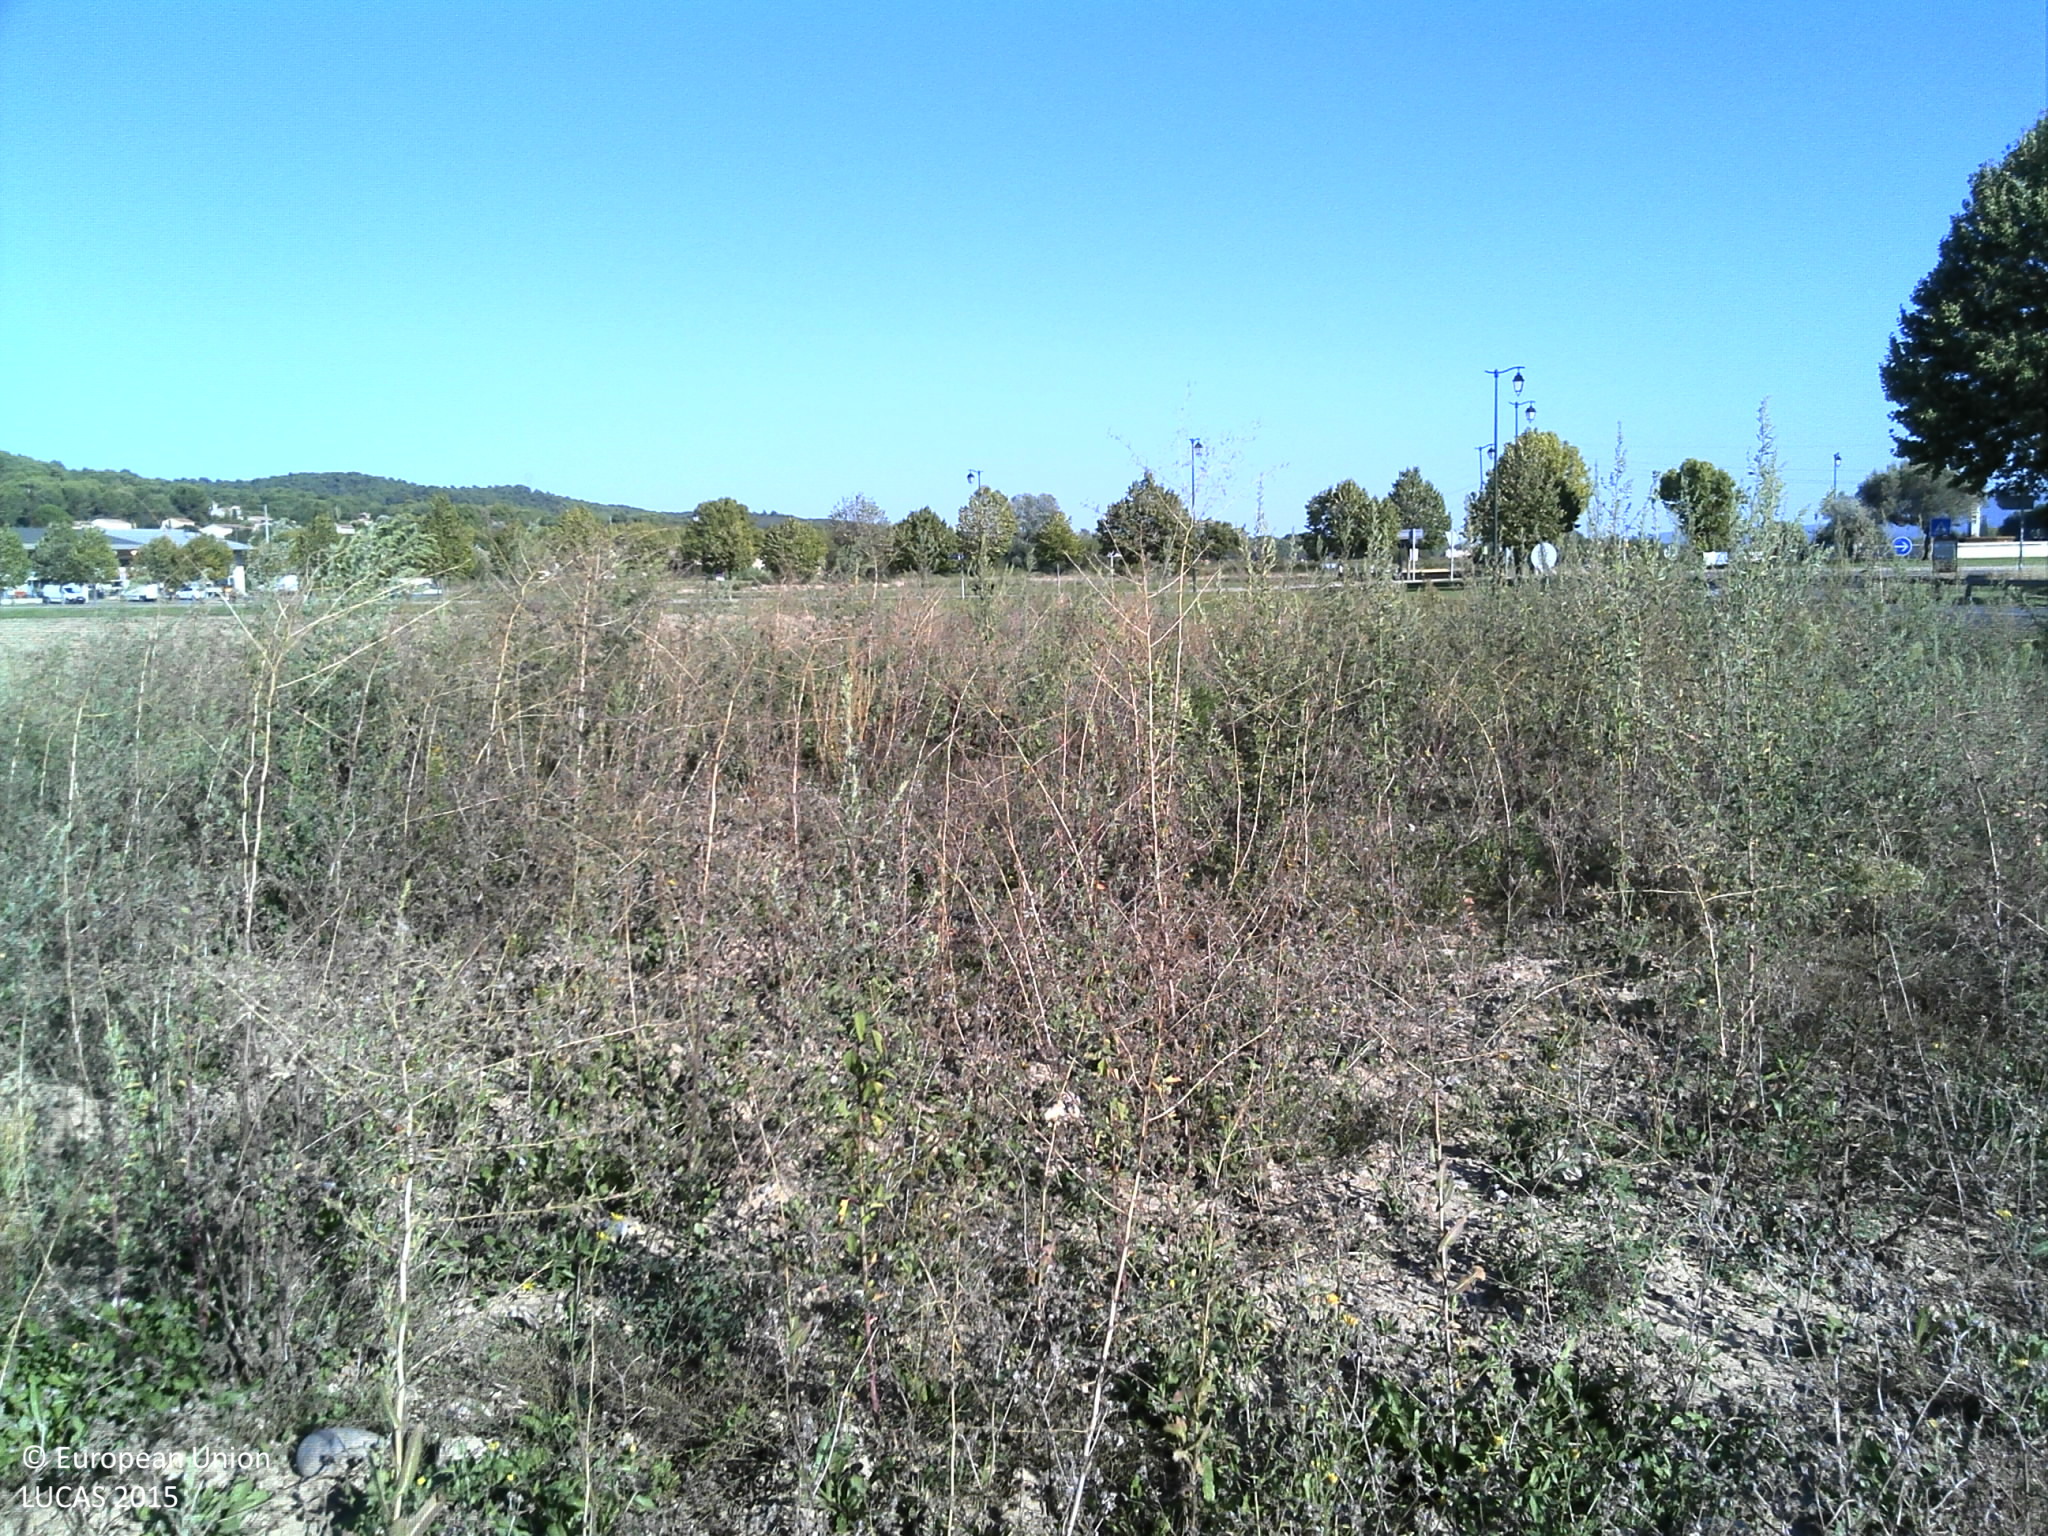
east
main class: Grassland
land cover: Spontaneously vegetated surfaces
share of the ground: > 75 %
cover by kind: herbaceous plants 70 %, unconsolidated bare surface 15 %, consolidated bare surface 10 %, shrubs 5 %
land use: Abandoned areas
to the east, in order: Spontaneously vegetated surfaces; Other bare soil; Grass margins; Lines of trees; Paved roads, cycling and walking lanes; Lines of trees; Spontaneously vegetated surfaces
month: September
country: FR
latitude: 43.7079
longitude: 5.4298
